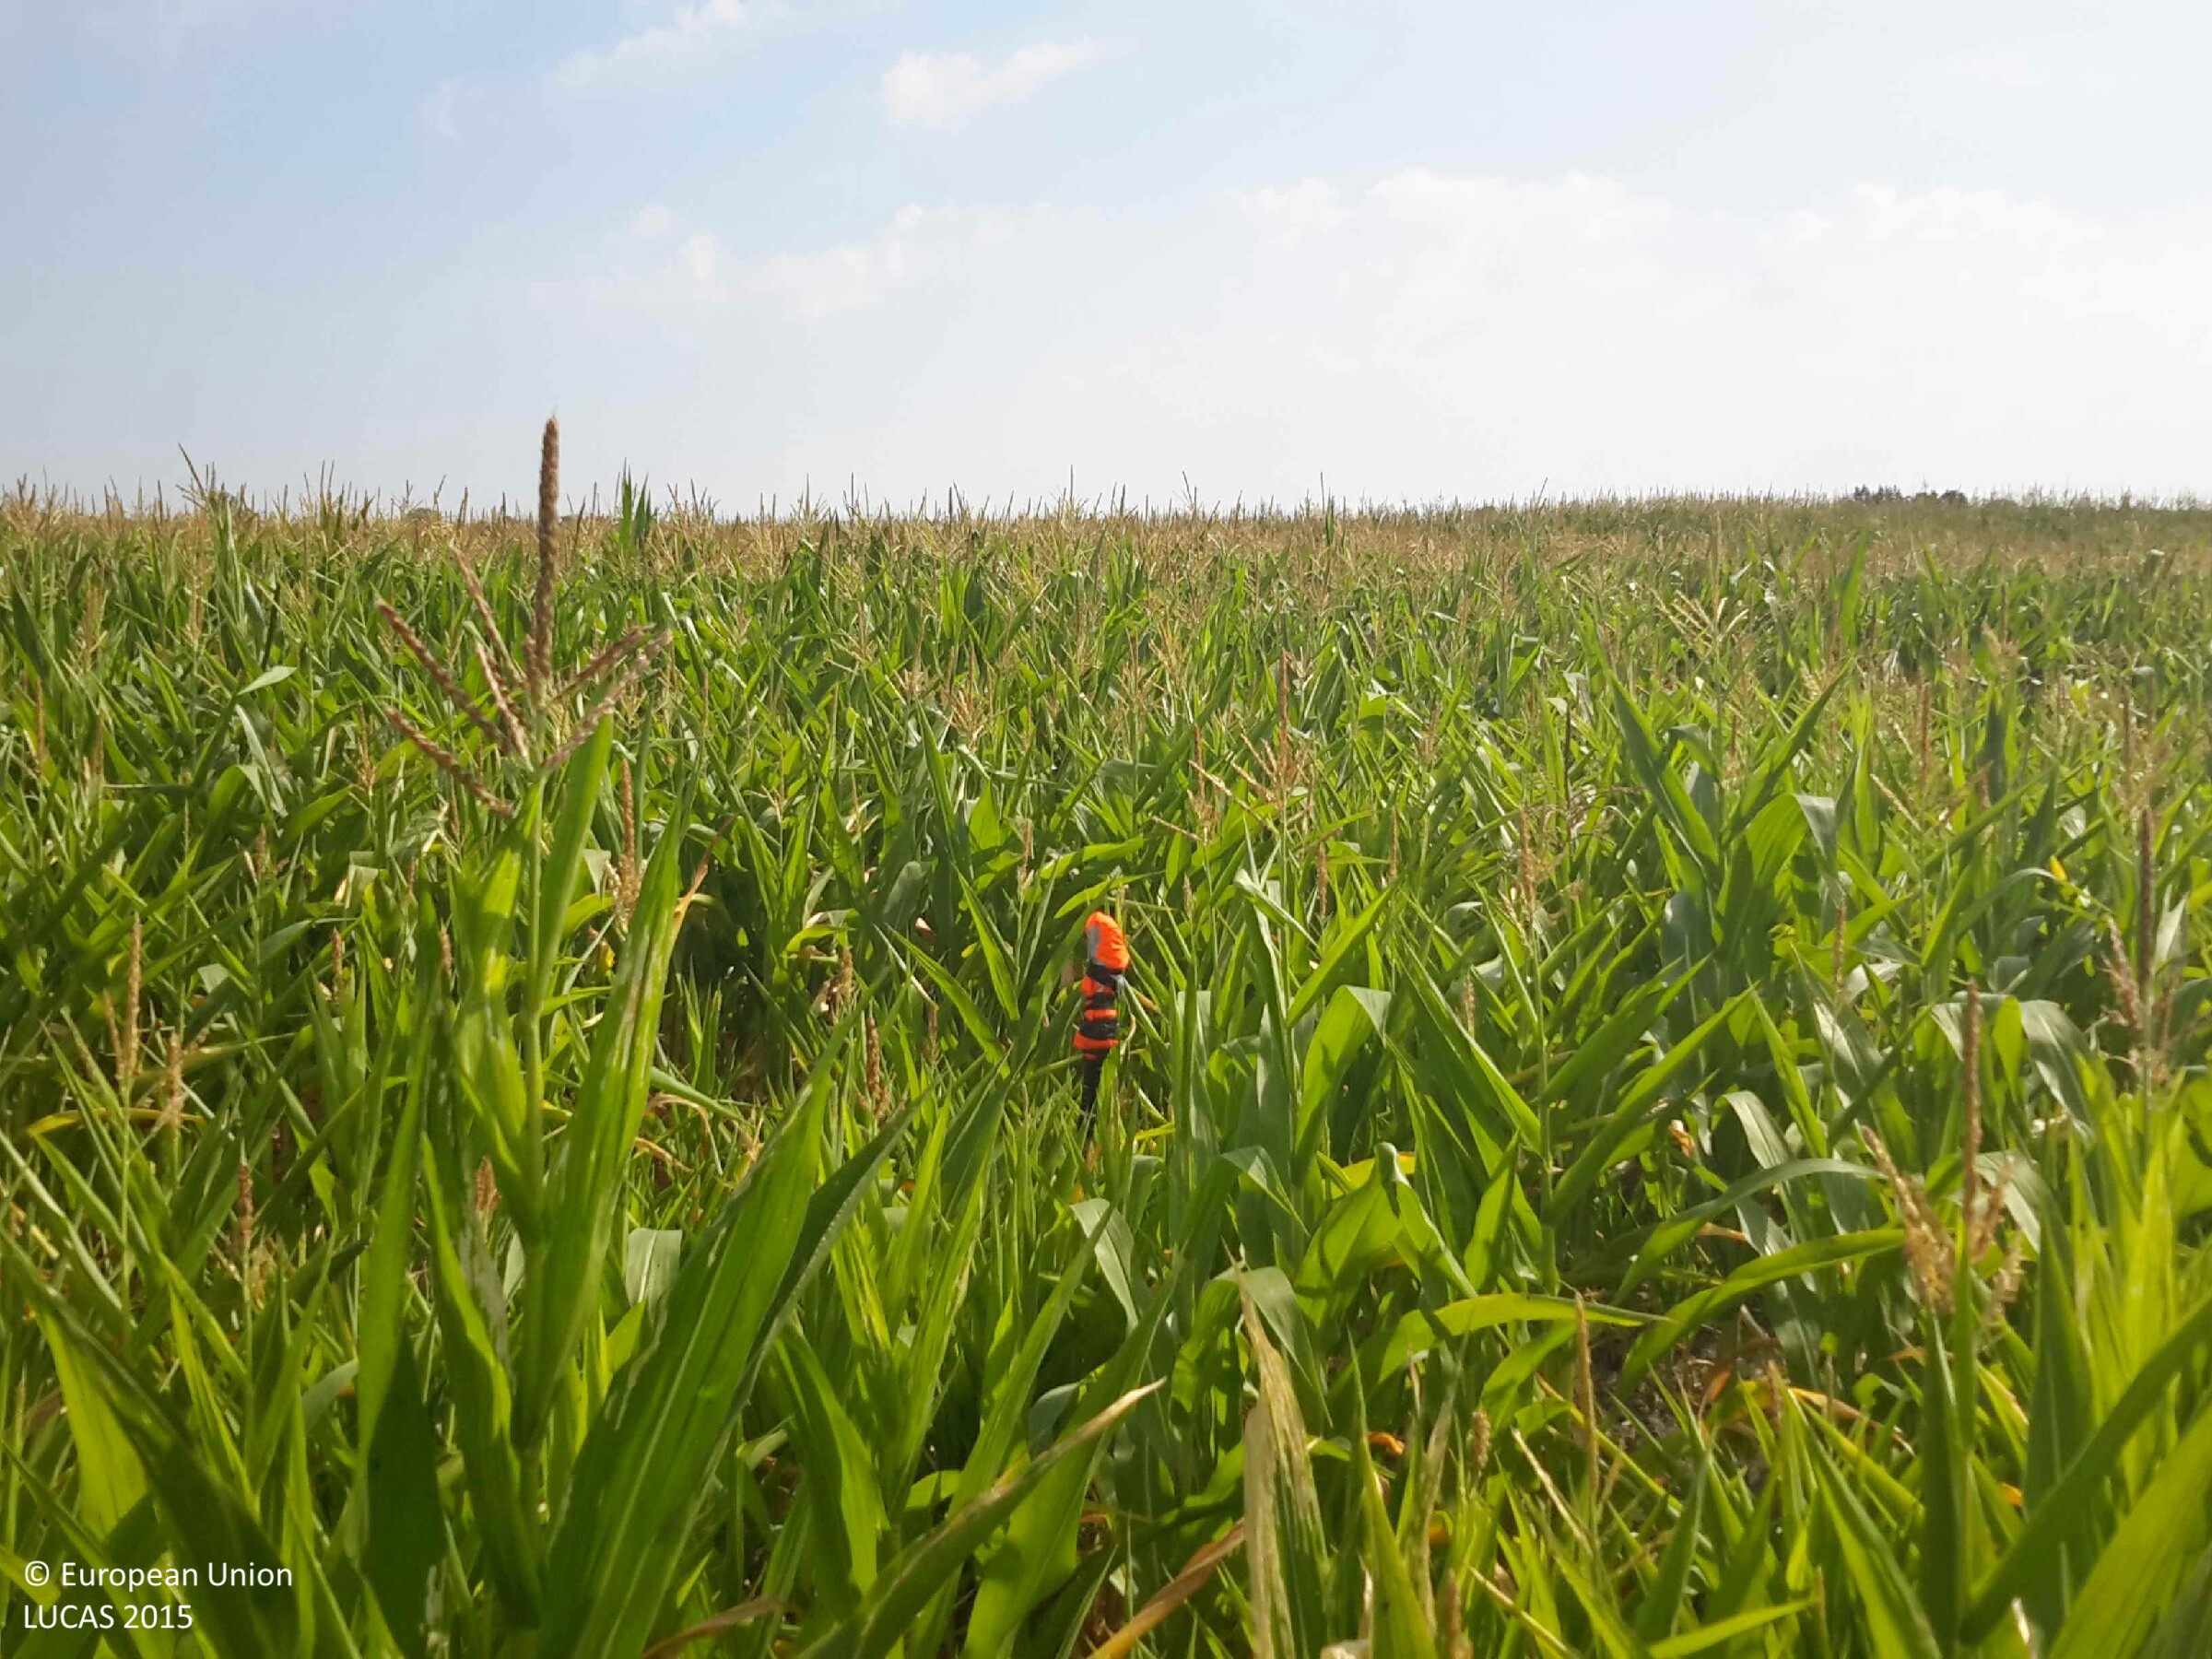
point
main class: Cropland
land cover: Maize
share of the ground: > 75 %
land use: Agriculture (excluding fallow land and kitchen gardens)
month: July
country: HU
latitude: 47.6124
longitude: 17.9263
